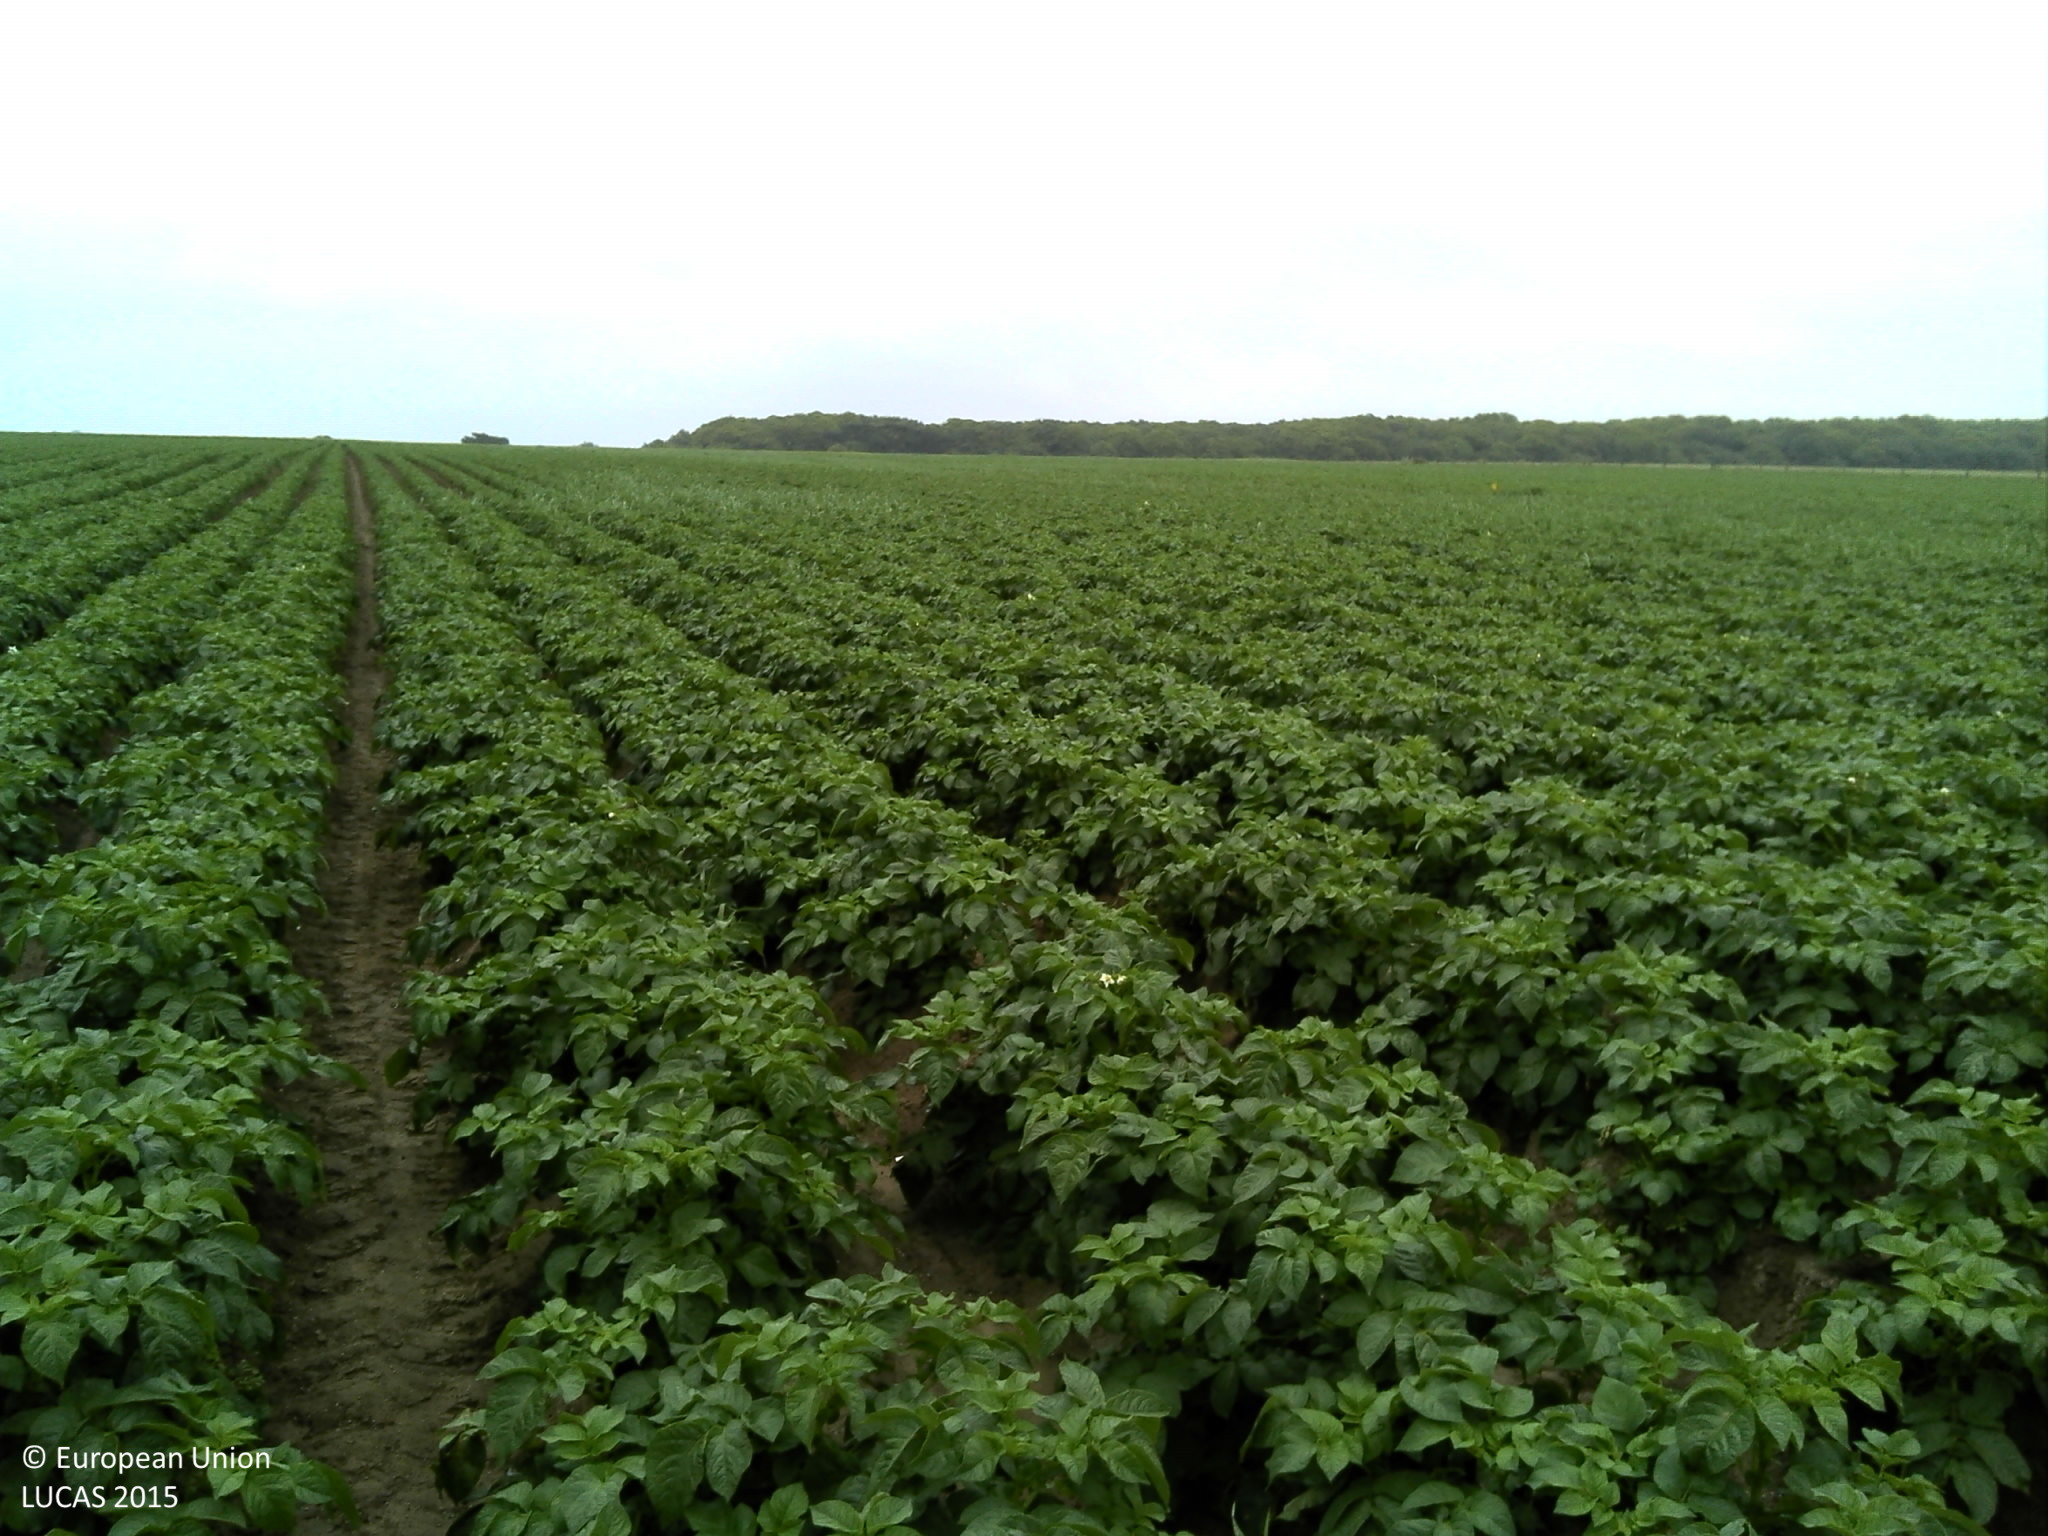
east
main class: Cropland
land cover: Potatoes
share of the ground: > 75 %
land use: Agriculture (excluding fallow land and kitchen gardens)
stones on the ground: < 10 %
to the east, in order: Potatoes; Other fibre and oleaginous crops
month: June
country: FR
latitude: 49.7336
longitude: 0.3007
